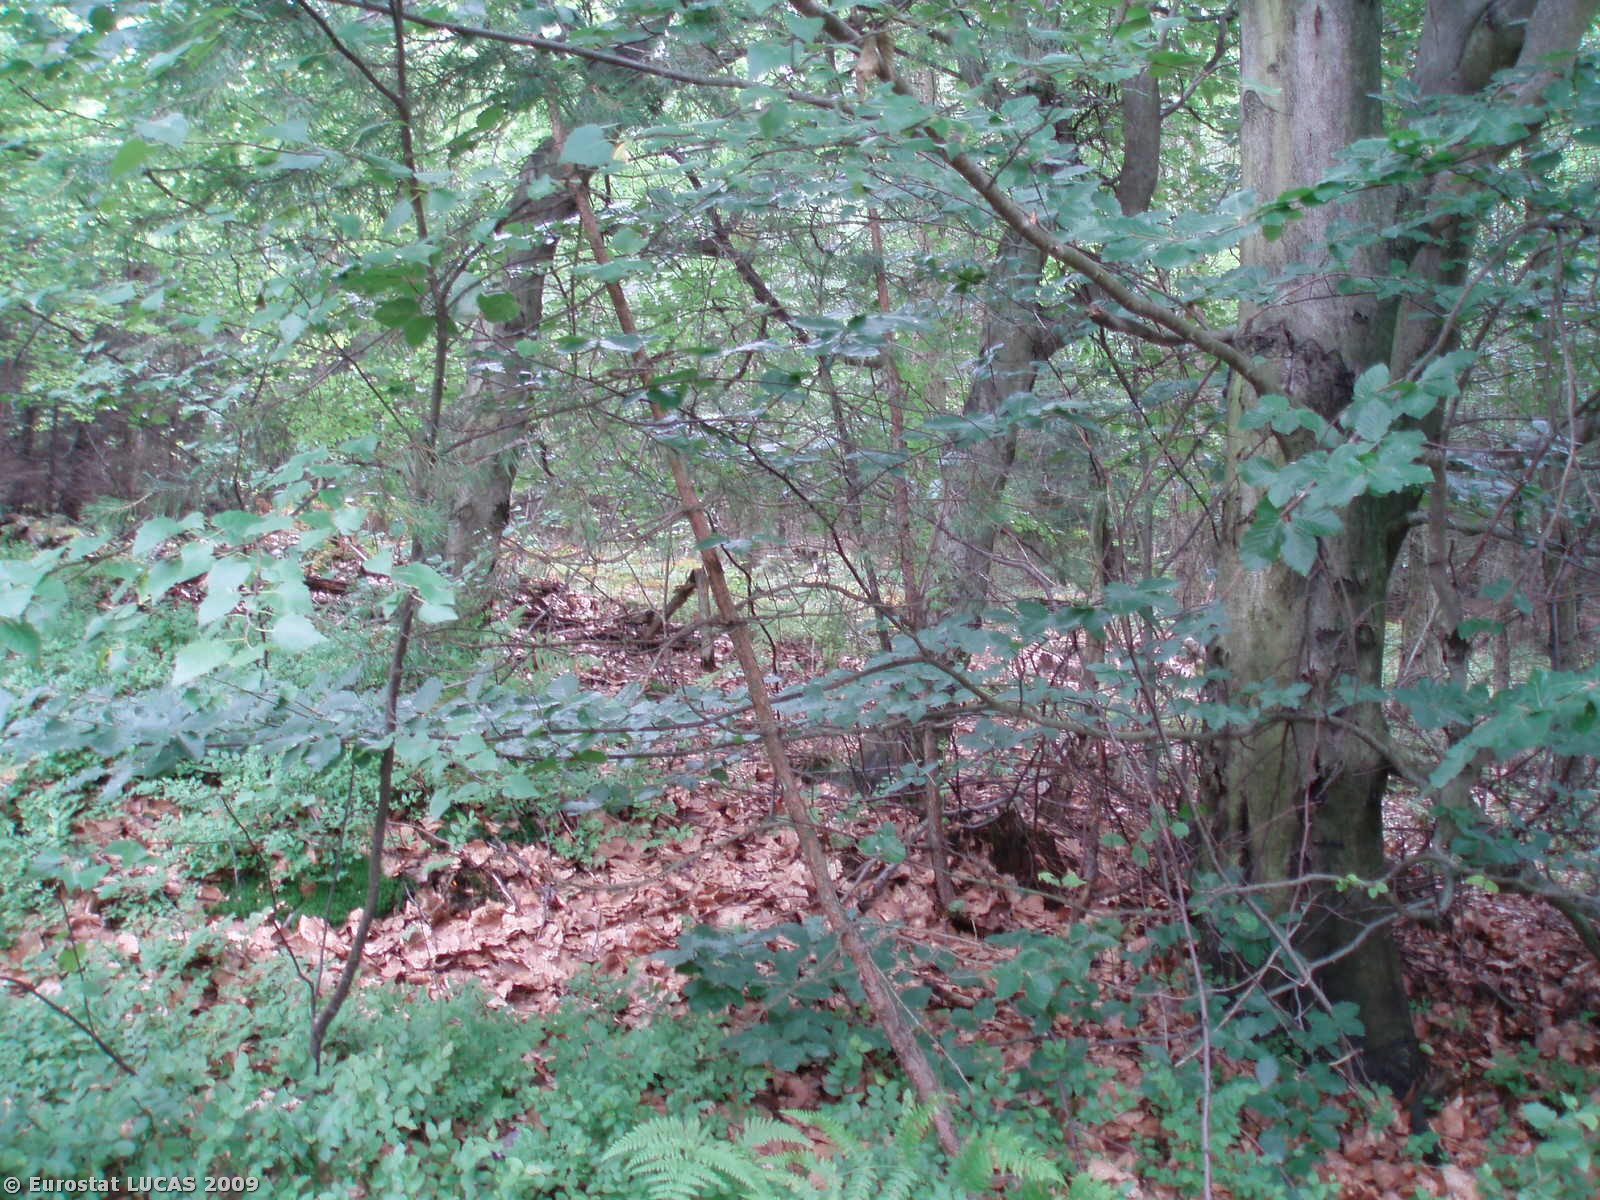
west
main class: Woodland
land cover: Mixed woodland
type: beech forest
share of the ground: > 75 %
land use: Forestry
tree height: > 5 m
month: July
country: CZ
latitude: 50.7906
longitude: 14.2145
